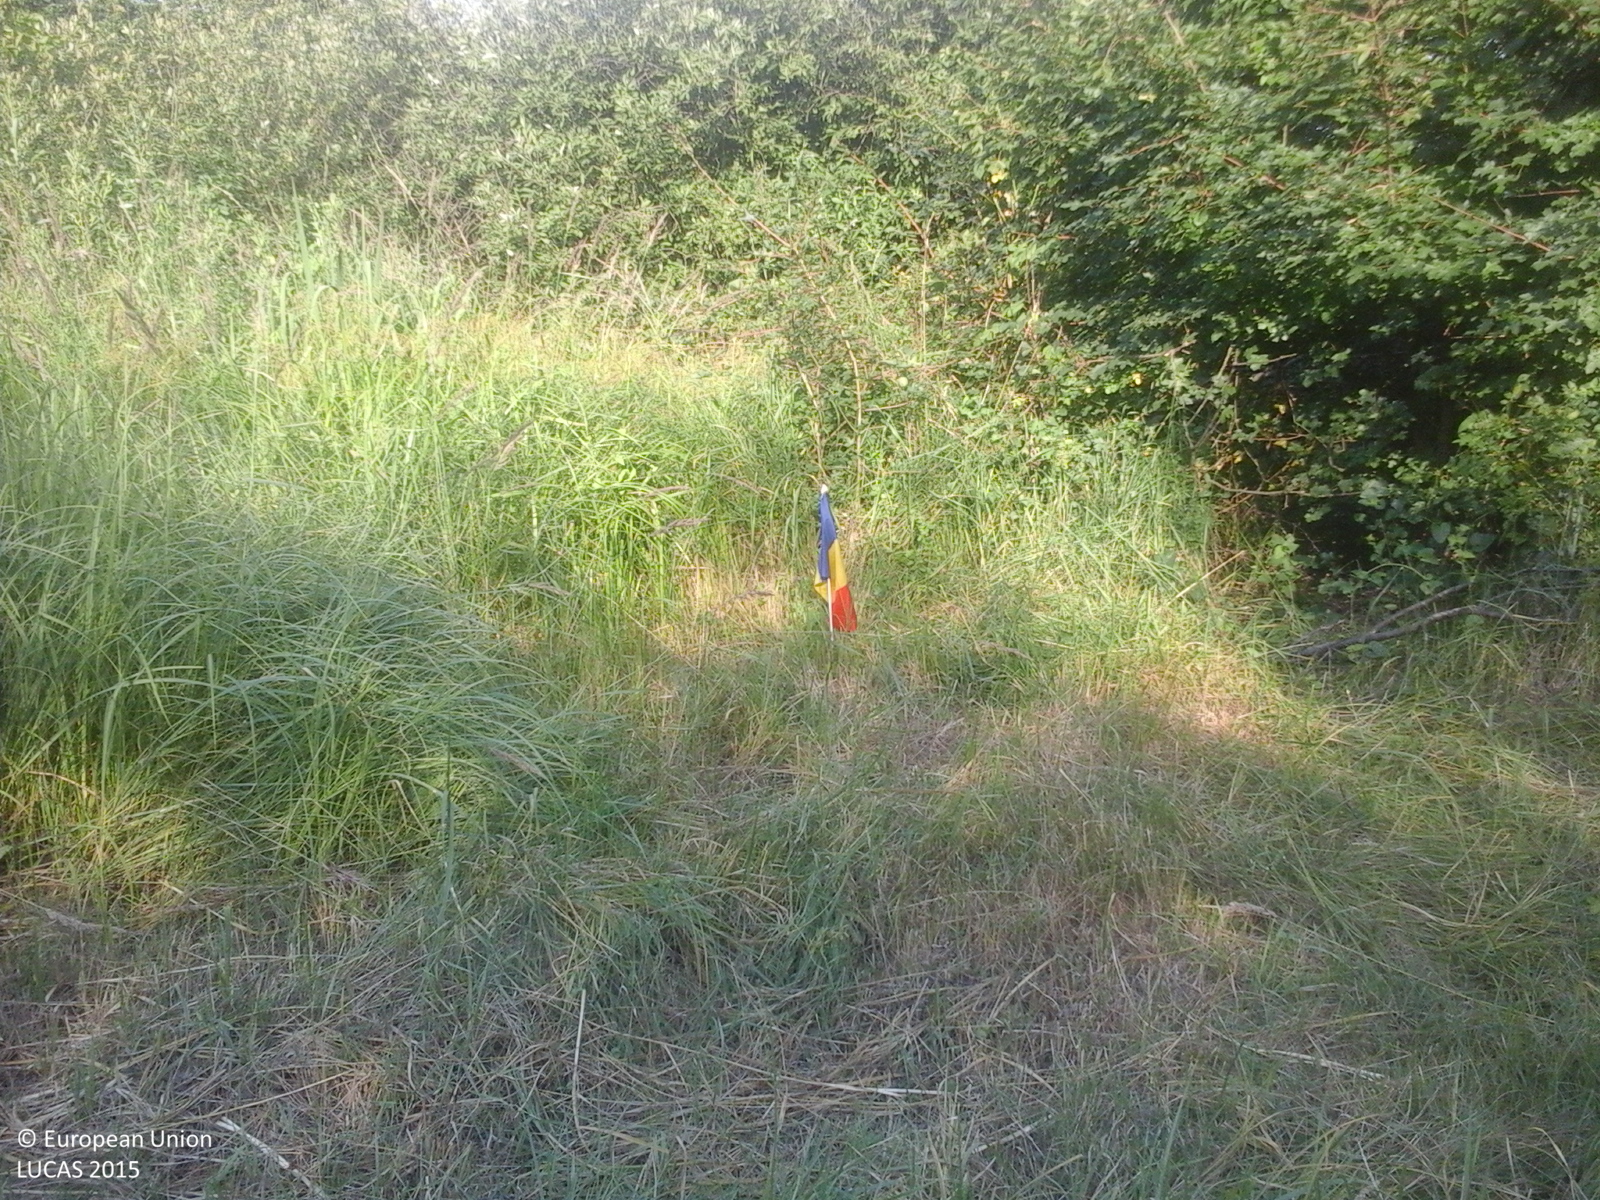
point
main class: Grassland
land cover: Grassland with sparse tree/shrub cover
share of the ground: > 75 %
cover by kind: herbaceous plants 85 %, shrubs 10 %, broadleaved forest trees 5 %
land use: Semi-natural and natural areas not in use
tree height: > 5 m
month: July
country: RO
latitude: 44.5224
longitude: 24.7080
